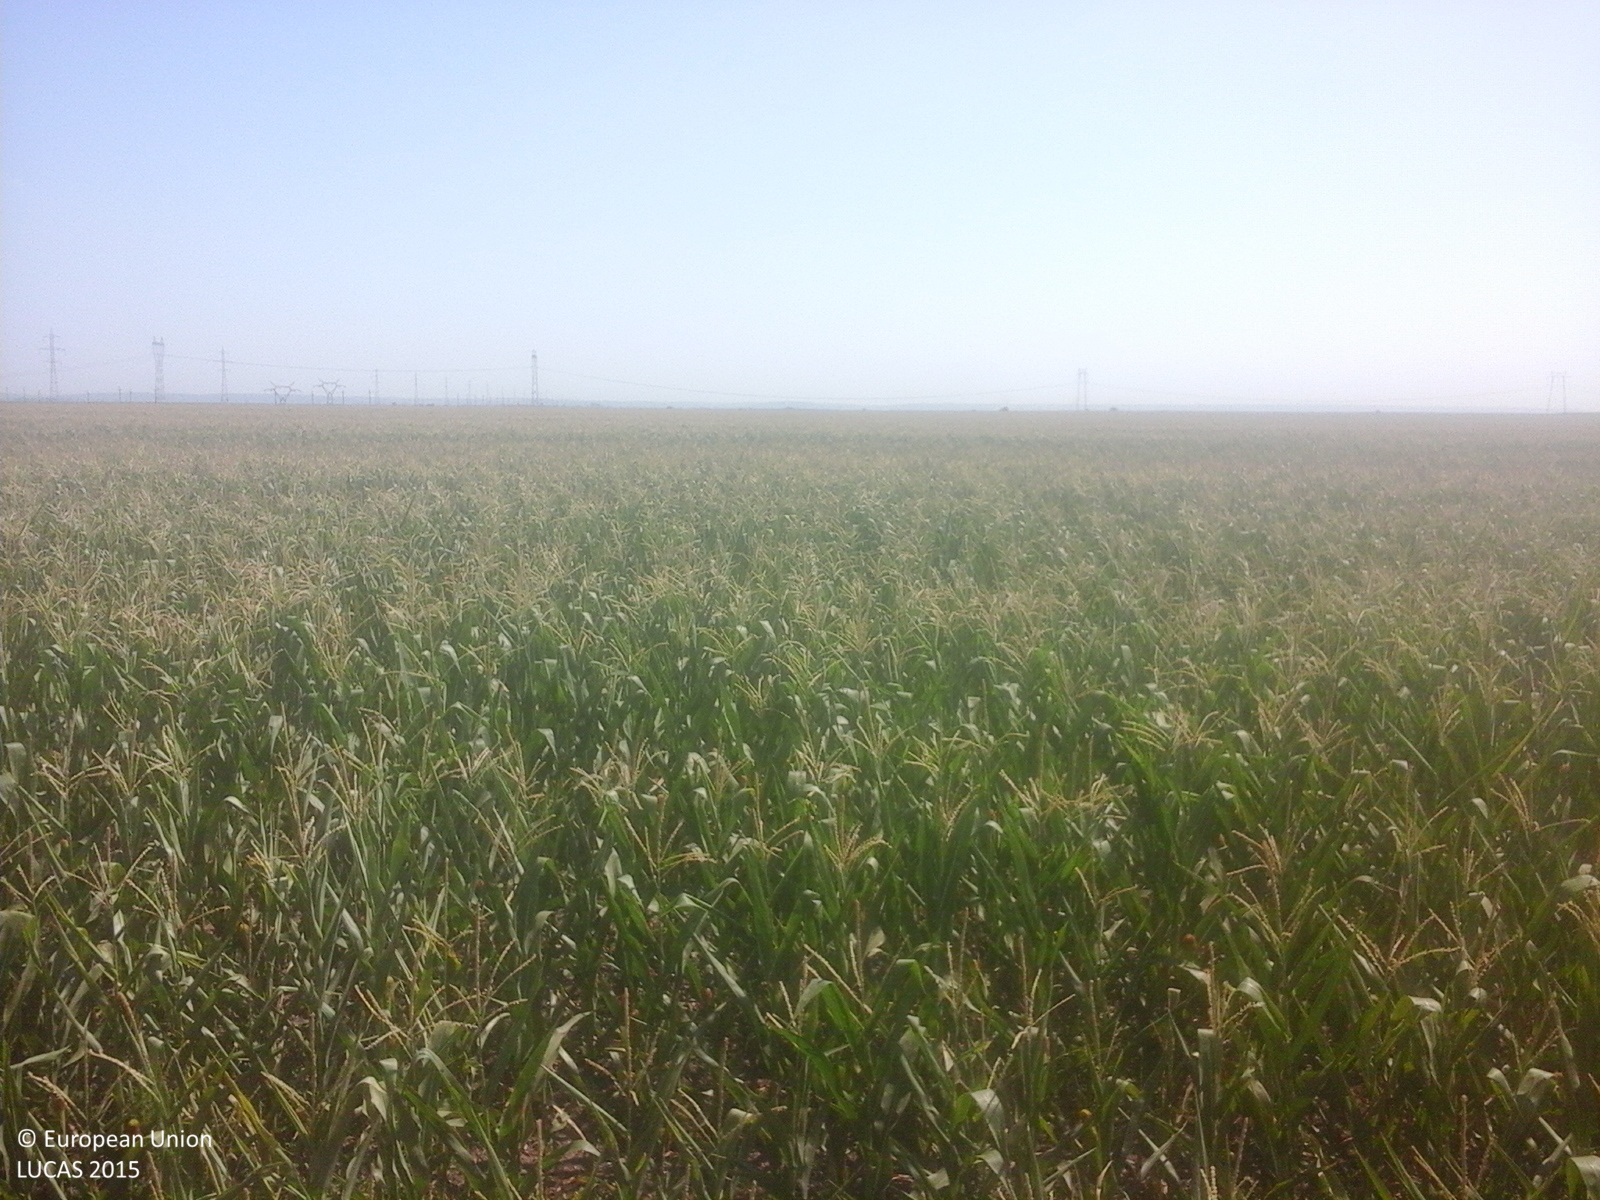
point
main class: Cropland
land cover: Maize
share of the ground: > 75 %
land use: Agriculture (excluding fallow land and kitchen gardens)
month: July
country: RO
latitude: 44.2172
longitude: 26.7024
